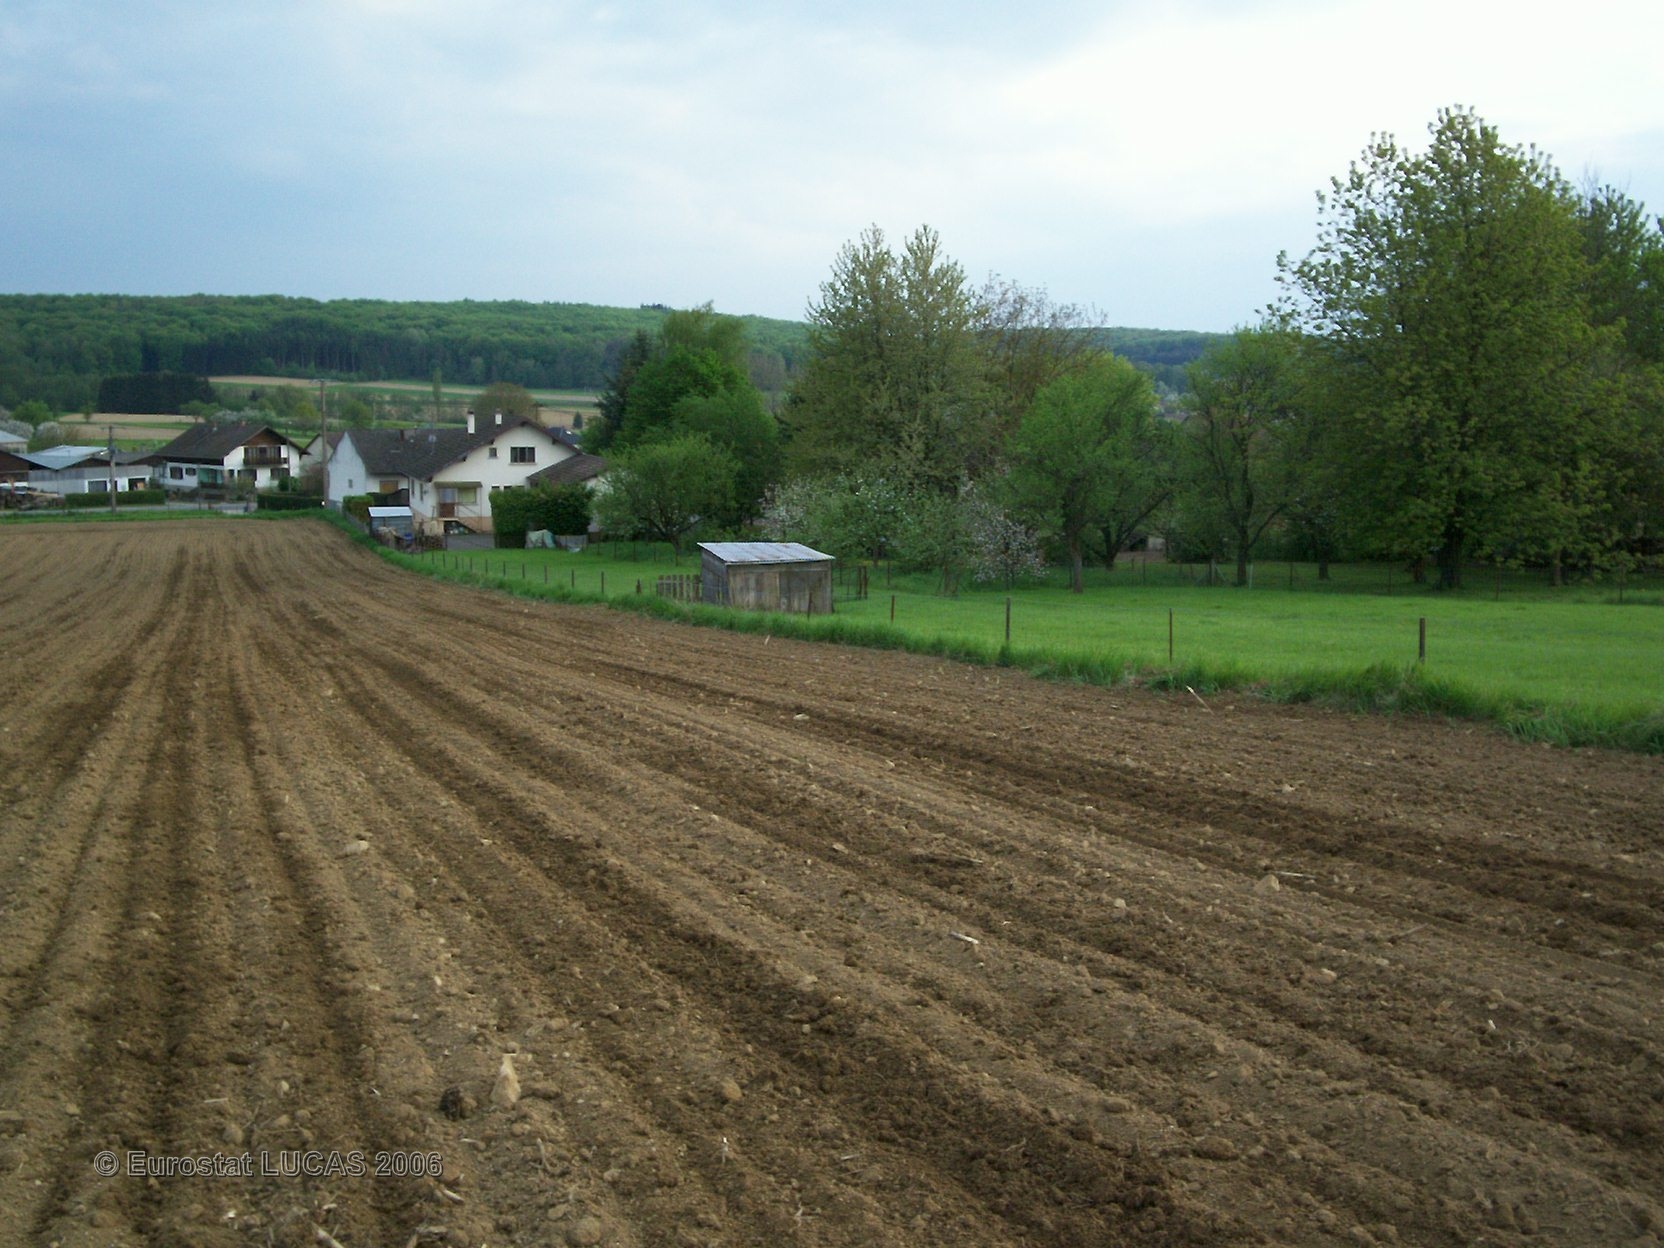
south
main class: Cropland
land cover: Maize
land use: Agriculture (excluding fallow land and kitchen gardens)
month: May
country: FR
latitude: 47.6289
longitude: 7.1670
